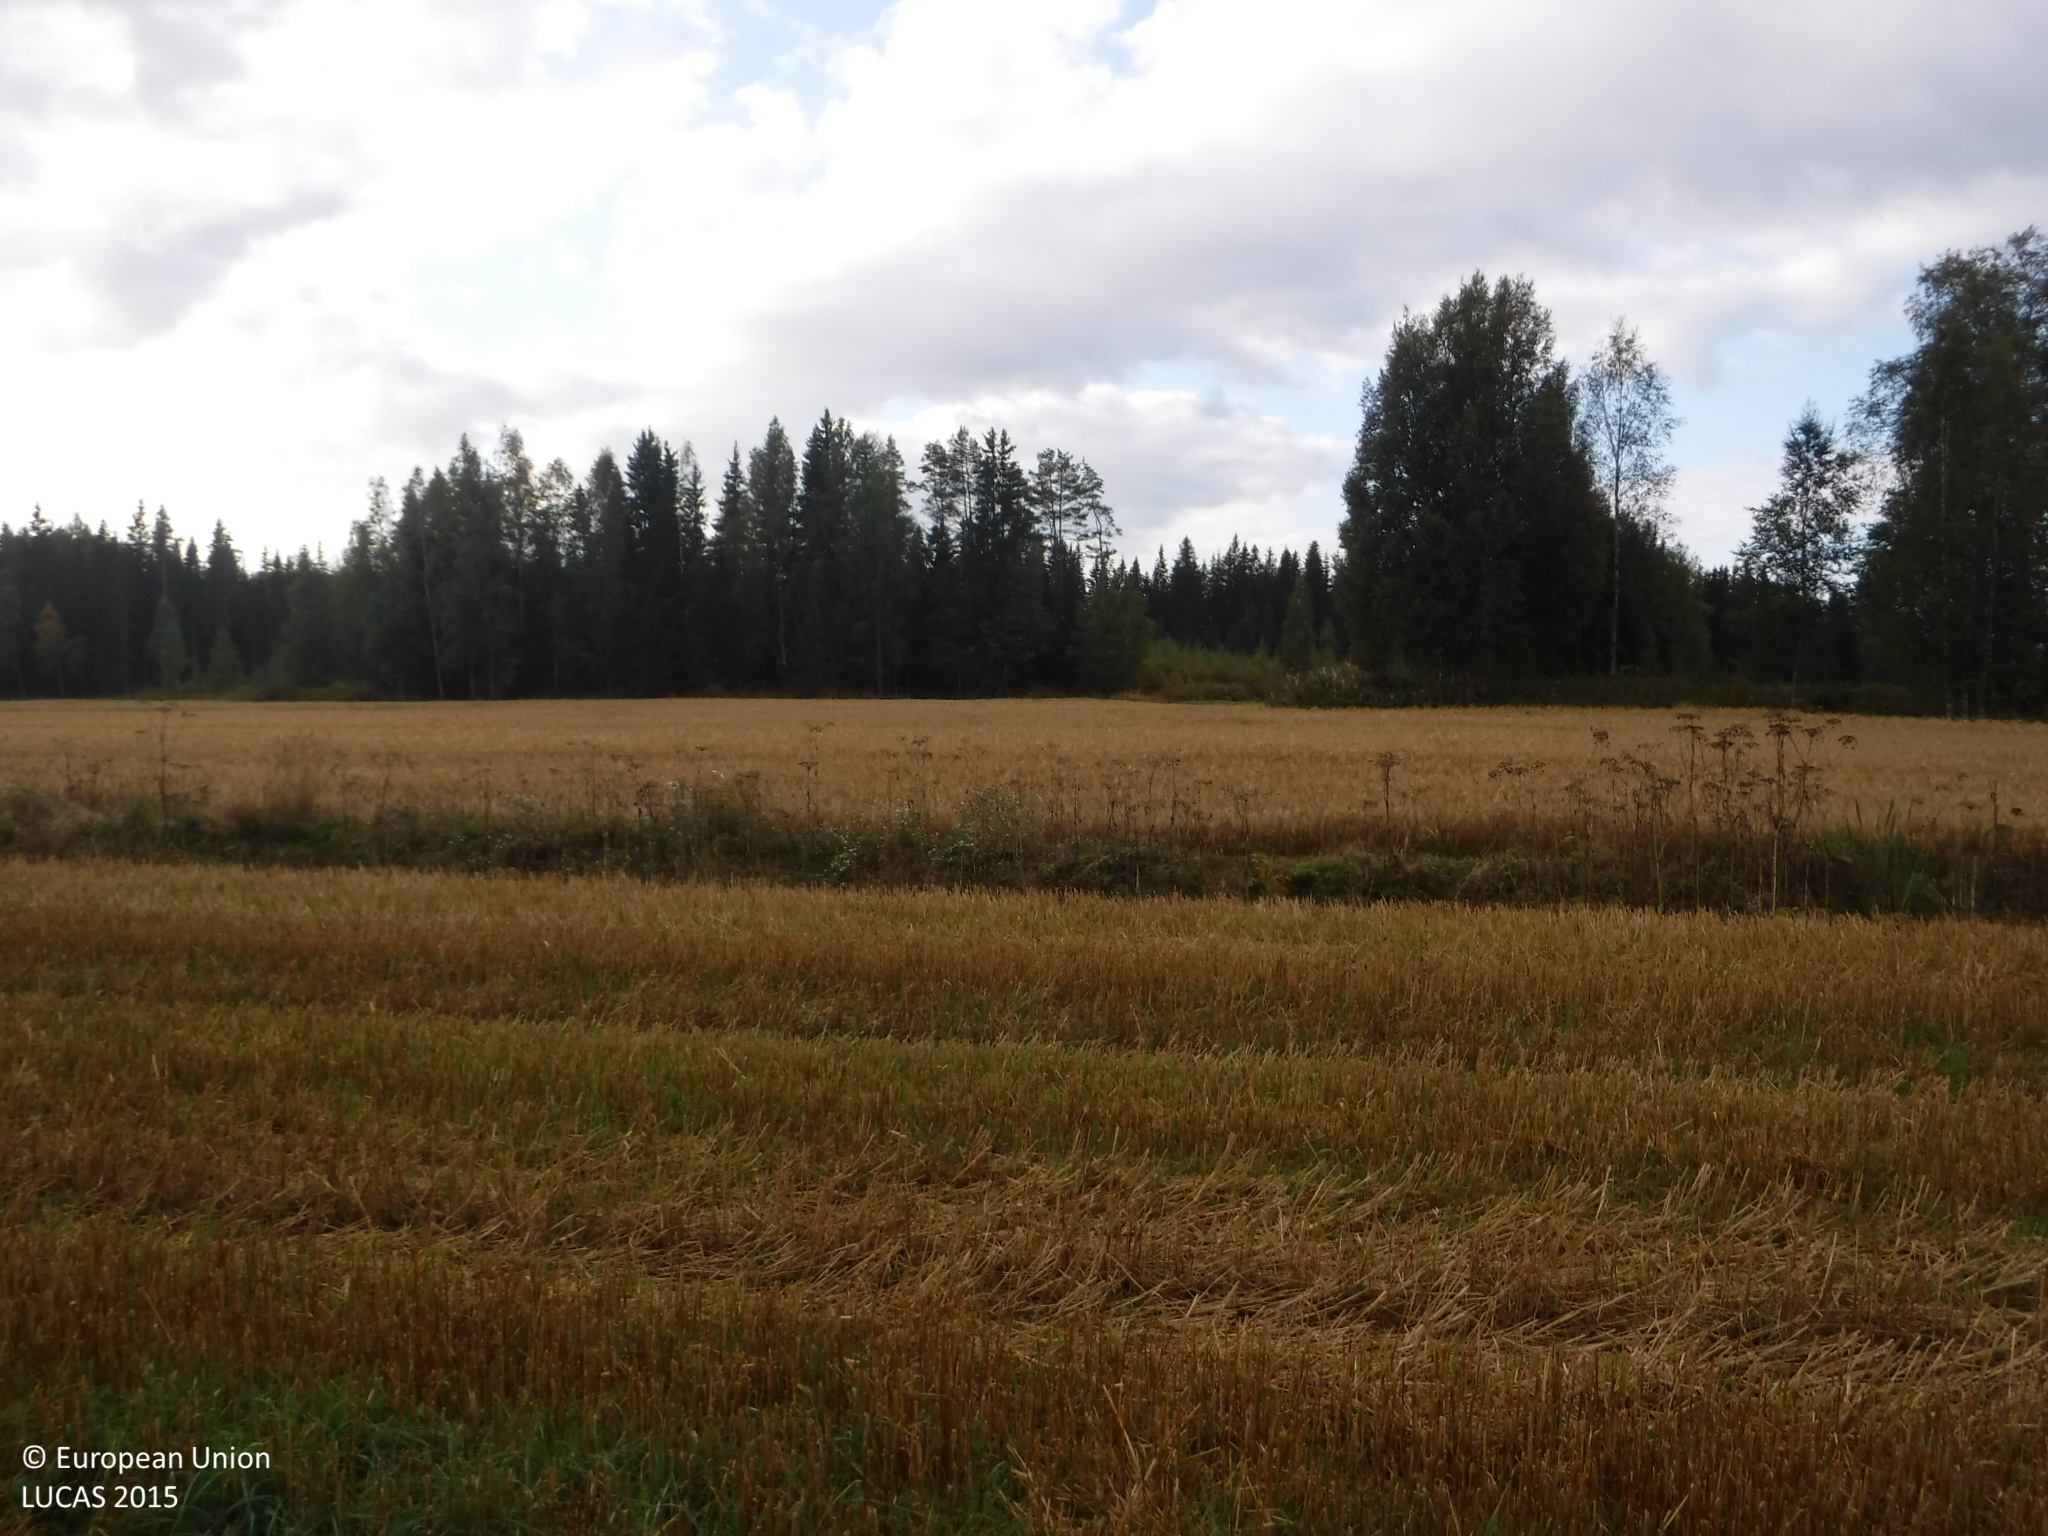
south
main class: Cropland
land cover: Barley
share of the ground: 25 - 50 %
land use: Agriculture (excluding fallow land and kitchen gardens)
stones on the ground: < 10 %
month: September
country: FI
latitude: 61.7458
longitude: 22.2339
